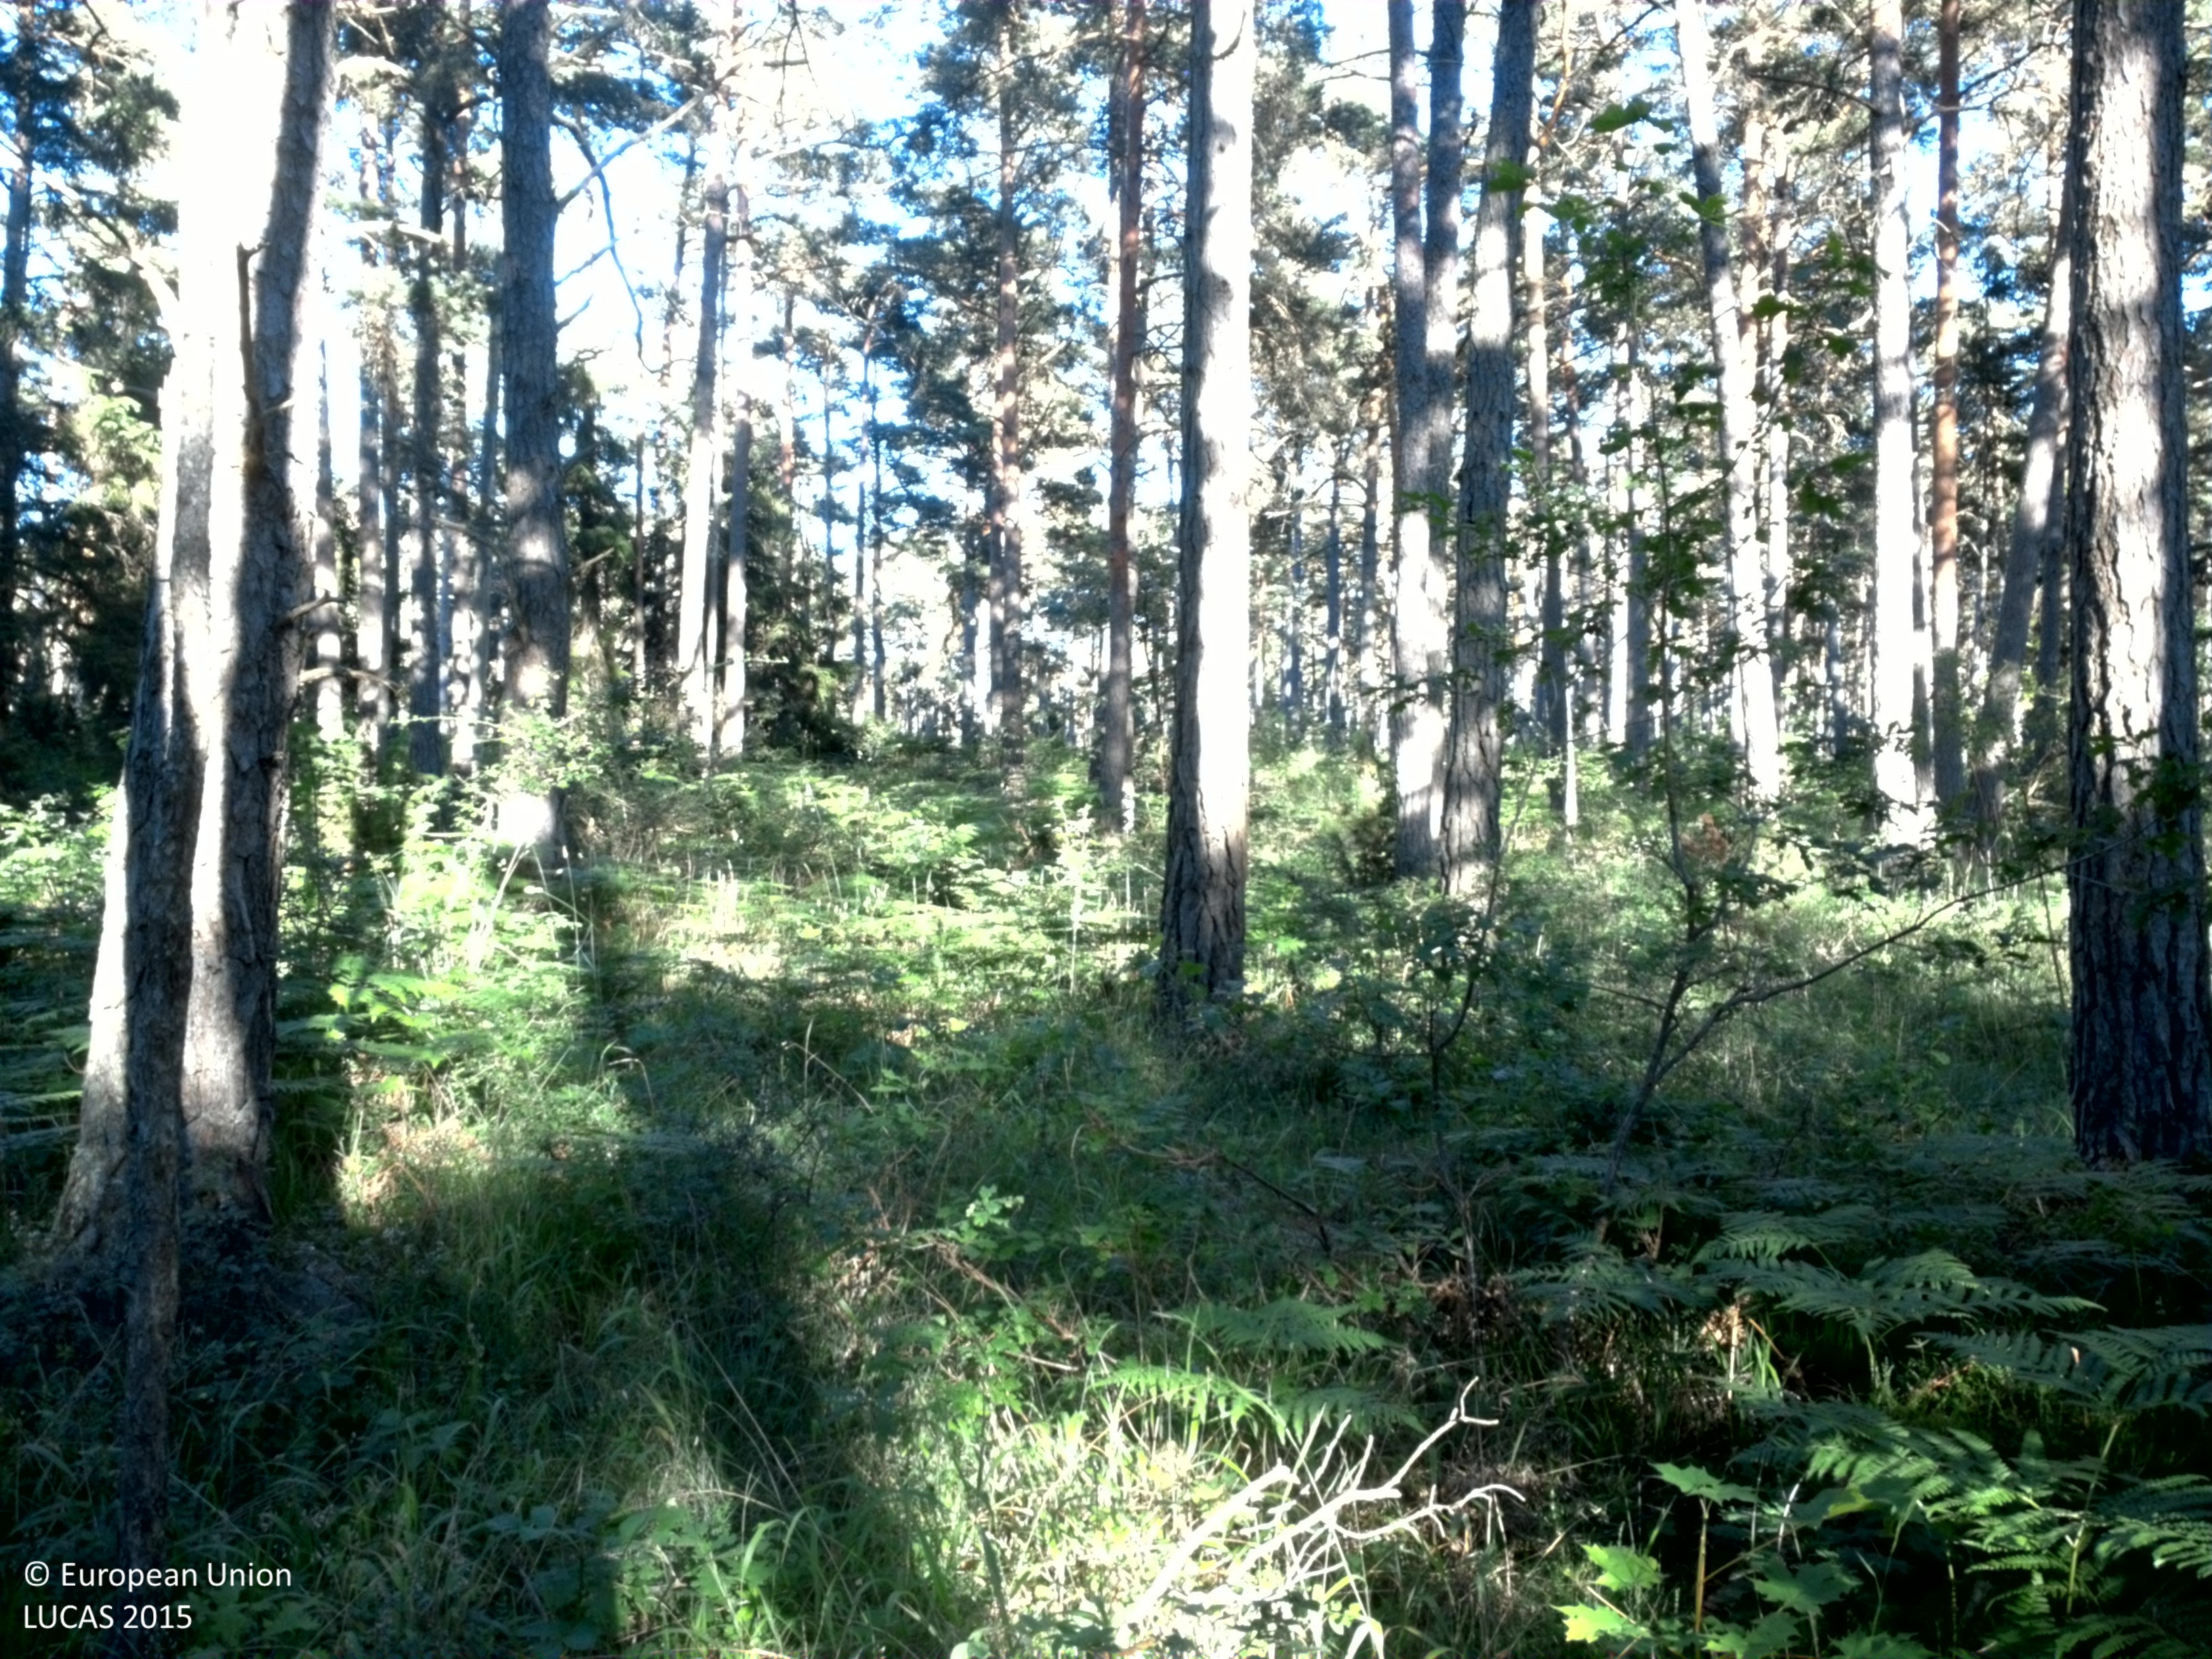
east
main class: Woodland
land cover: Pine dominated coniferous woodland
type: hemiboreal forest and nemoral coniferous forest and mixed broadleaved-coniferous forest
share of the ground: > 75 %
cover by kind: coniferous forest trees 80 %, herbaceous plants 15 %, broadleaved forest trees 5 %
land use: Forestry
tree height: > 5 m
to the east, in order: Pine dominated coniferous woodland; Tracks; Pine dominated coniferous woodland; Fences; Pine dominated coniferous woodland; Electric lines; Pine dominated coniferous woodland; Grassland with sparse tree/shrub cover
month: July
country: SE
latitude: 57.8006
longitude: 18.5723
